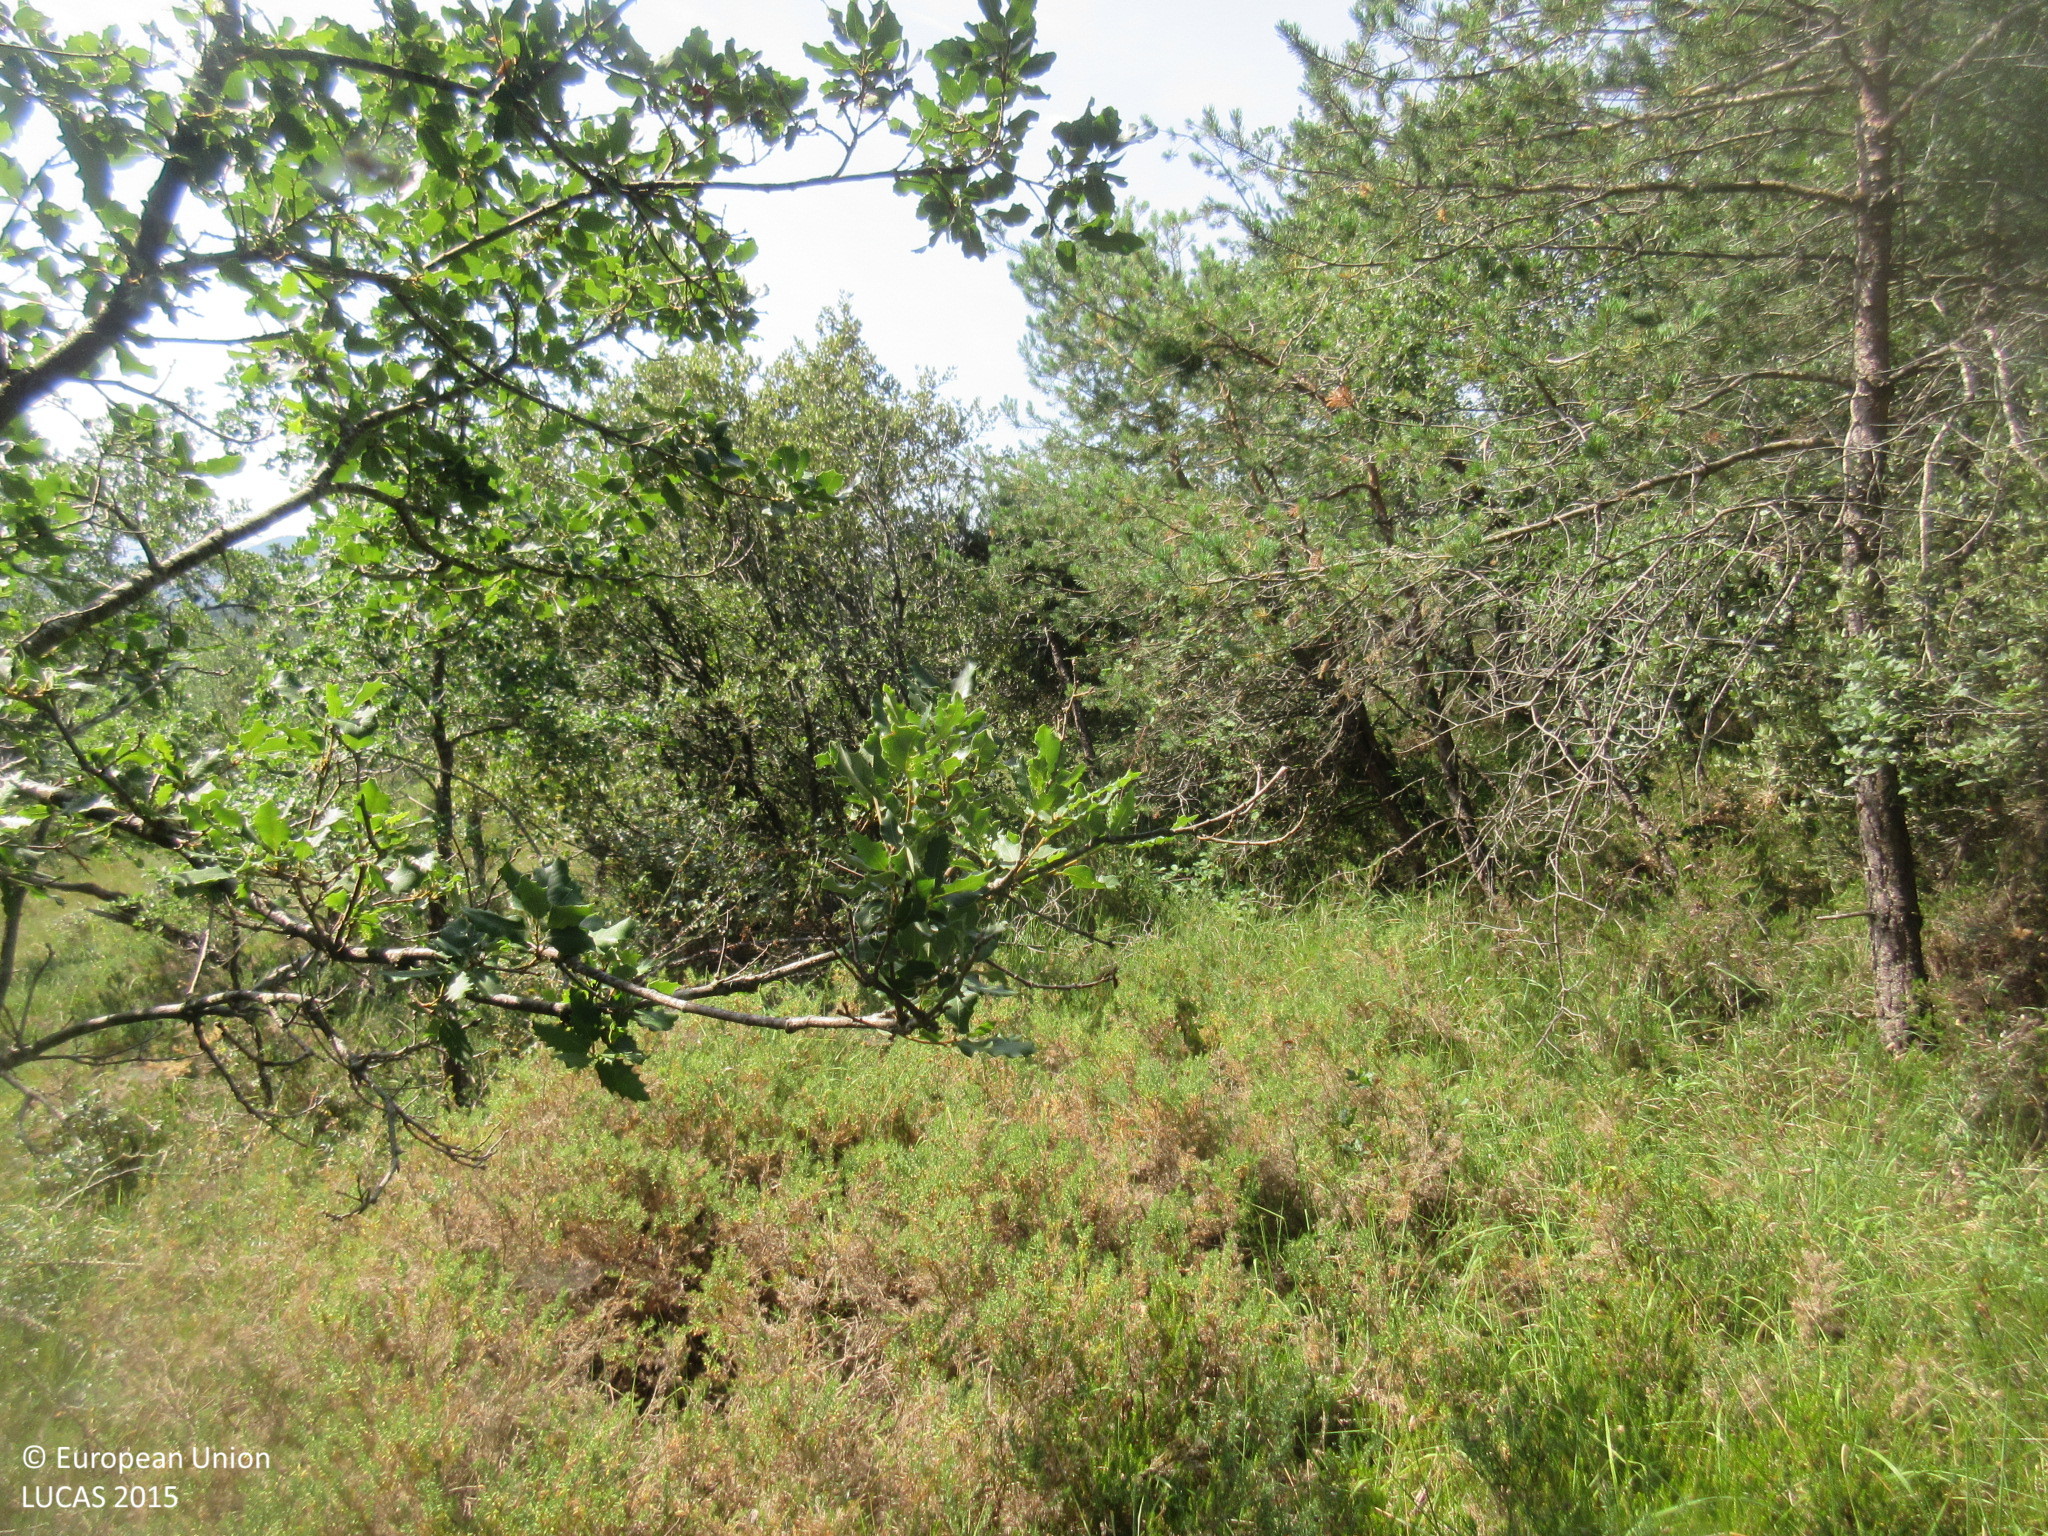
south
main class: Woodland
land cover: Broadleaved woodland
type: broadleaved evergreen forest
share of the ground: > 75 %
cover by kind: broadleaved forest trees 80 %, shrubs 20 %
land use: Forestry
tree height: > 5 m
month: July
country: ES
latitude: 42.9910
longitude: -3.3449
